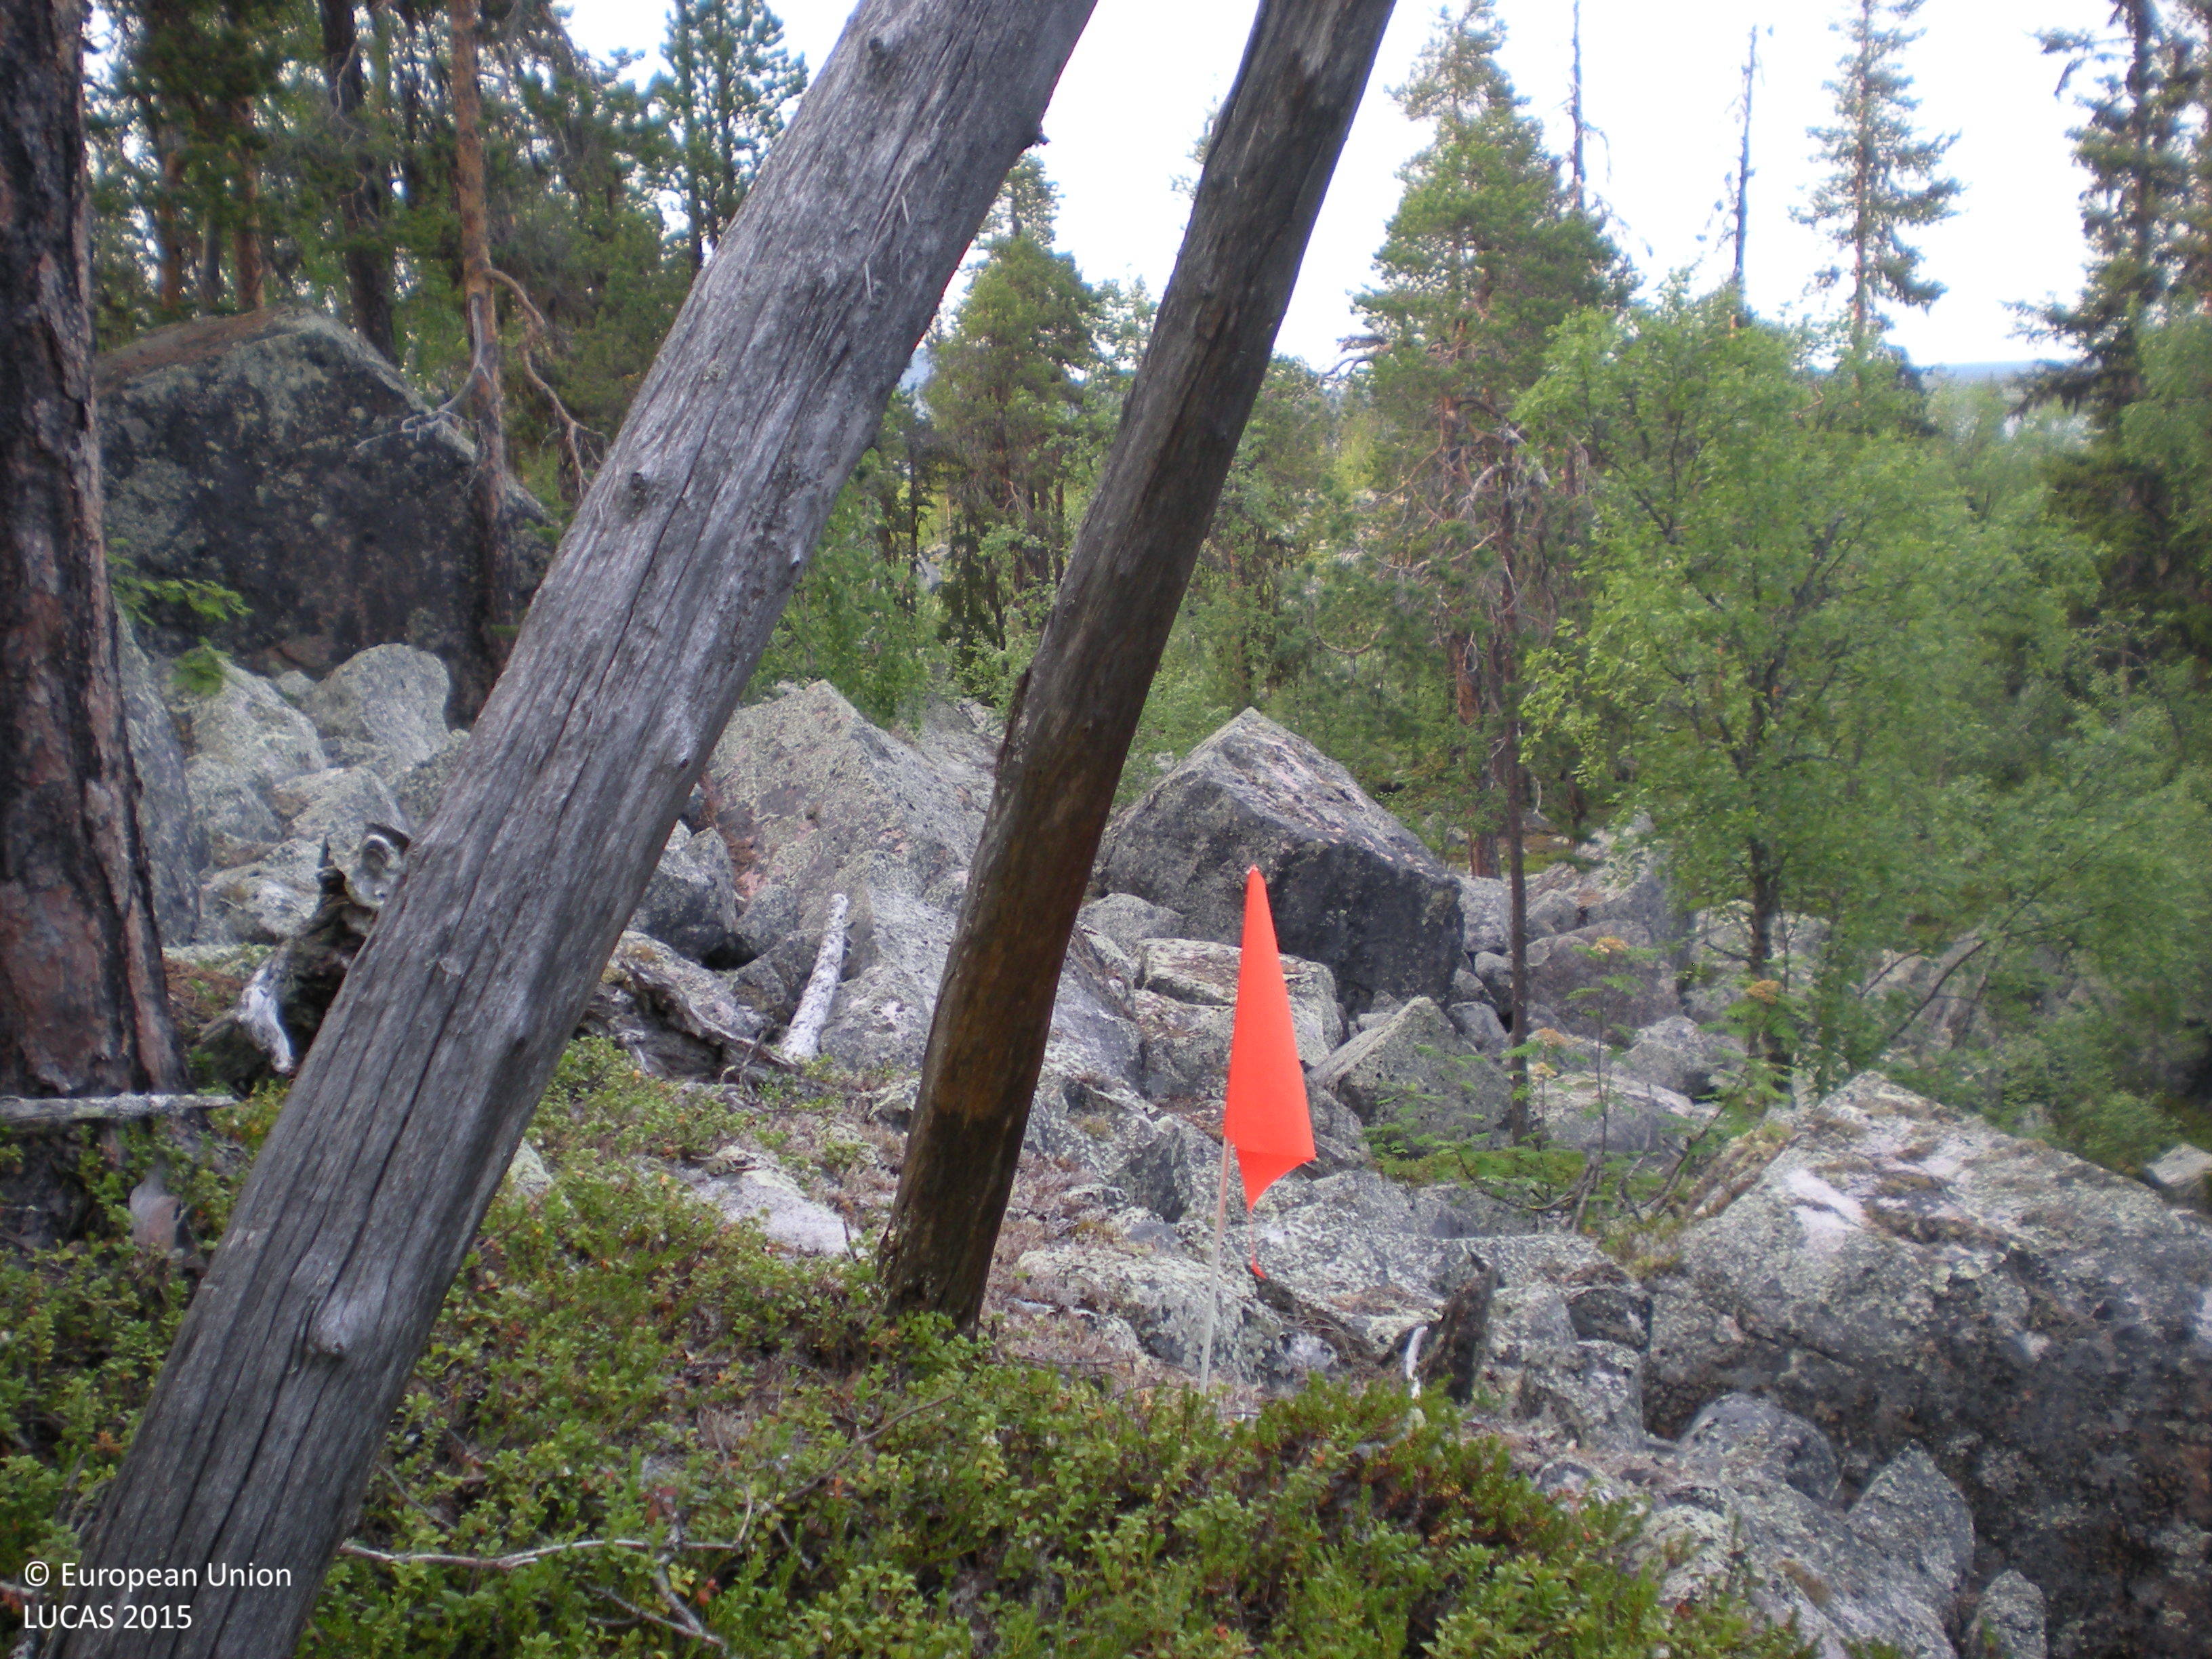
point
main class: Woodland
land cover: Pine dominated coniferous woodland
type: boreal forest
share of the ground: 10 - 25 %
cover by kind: consolidated bare surface 70 %, coniferous forest trees 15 %, shrubs 10 %, broadleaved forest trees 5 %
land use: Semi-natural and natural areas not in use
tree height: > 5 m
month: July
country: SE
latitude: 65.6923
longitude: 17.0781
